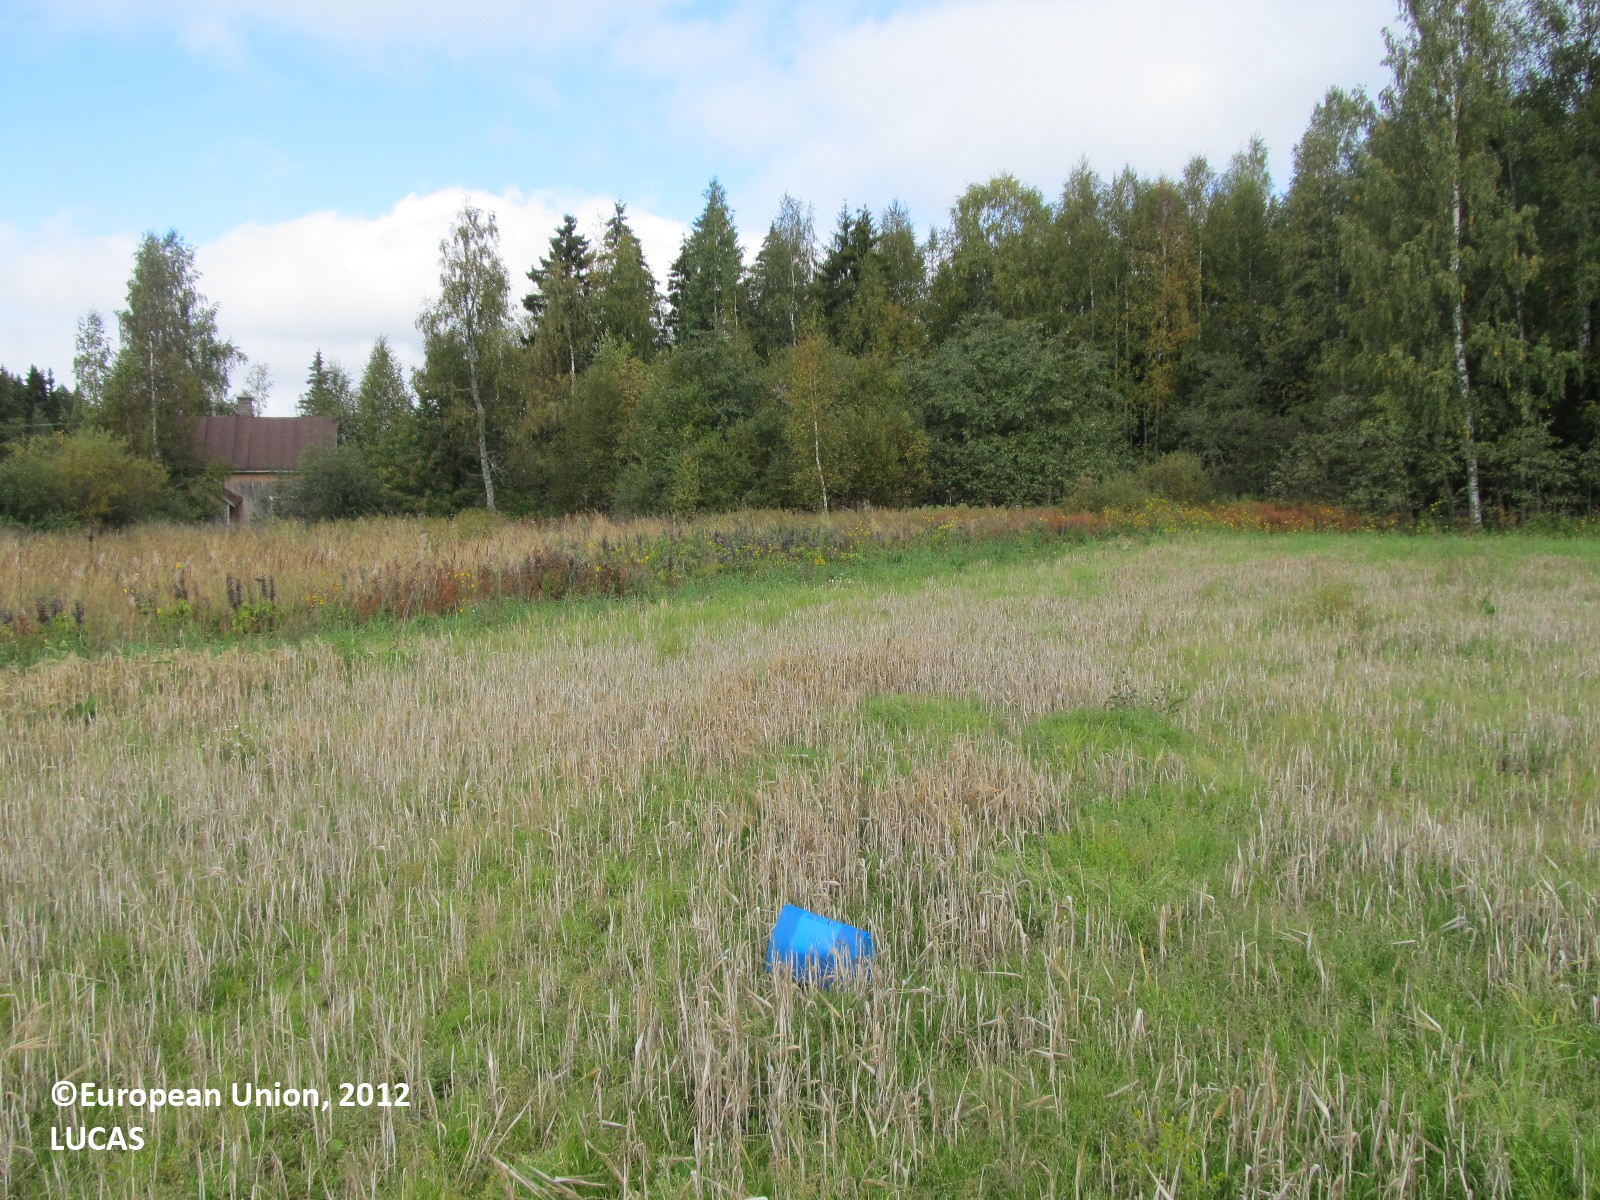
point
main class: Cropland
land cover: Barley
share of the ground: 25 - 50 %
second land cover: Grassland without tree/shrub cover
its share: 50 - 75 %
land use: Agriculture (excluding fallow land and kitchen gardens)
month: September
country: FI
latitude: 62.9376
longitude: 28.2130
